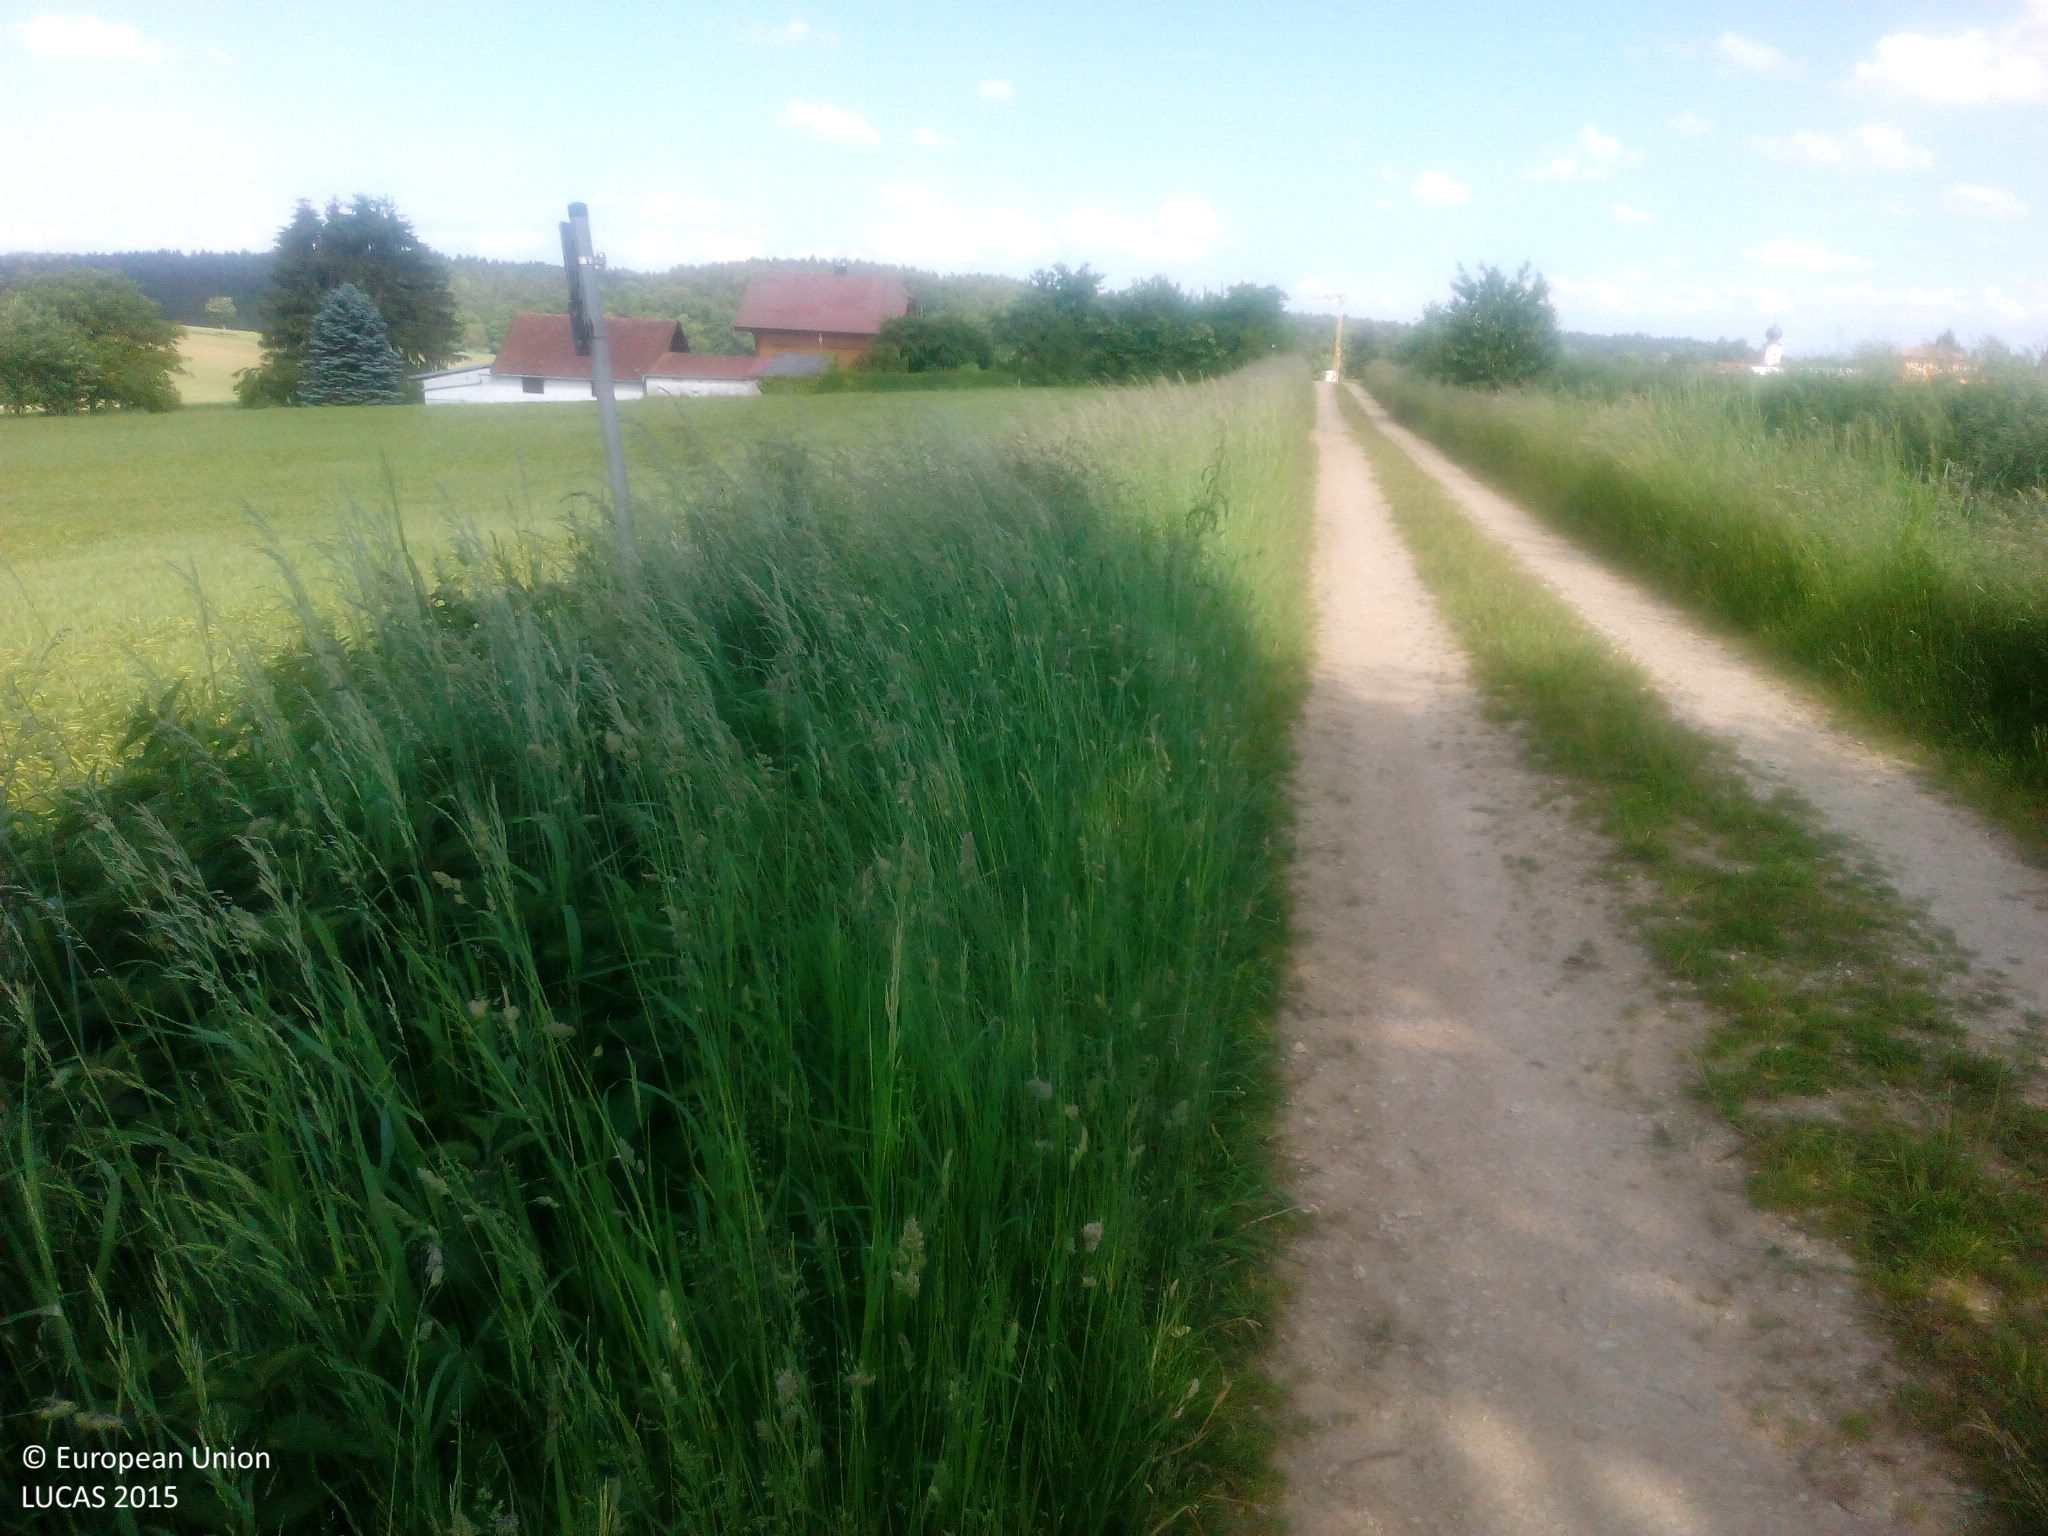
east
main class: Cropland
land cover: Rye
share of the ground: > 75 %
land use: Agriculture (excluding fallow land and kitchen gardens)
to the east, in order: Rye; Artificial constructions in urban areas; Grassland without tree/shrub cover; Barley
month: June
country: DE
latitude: 48.7439
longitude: 12.0799
